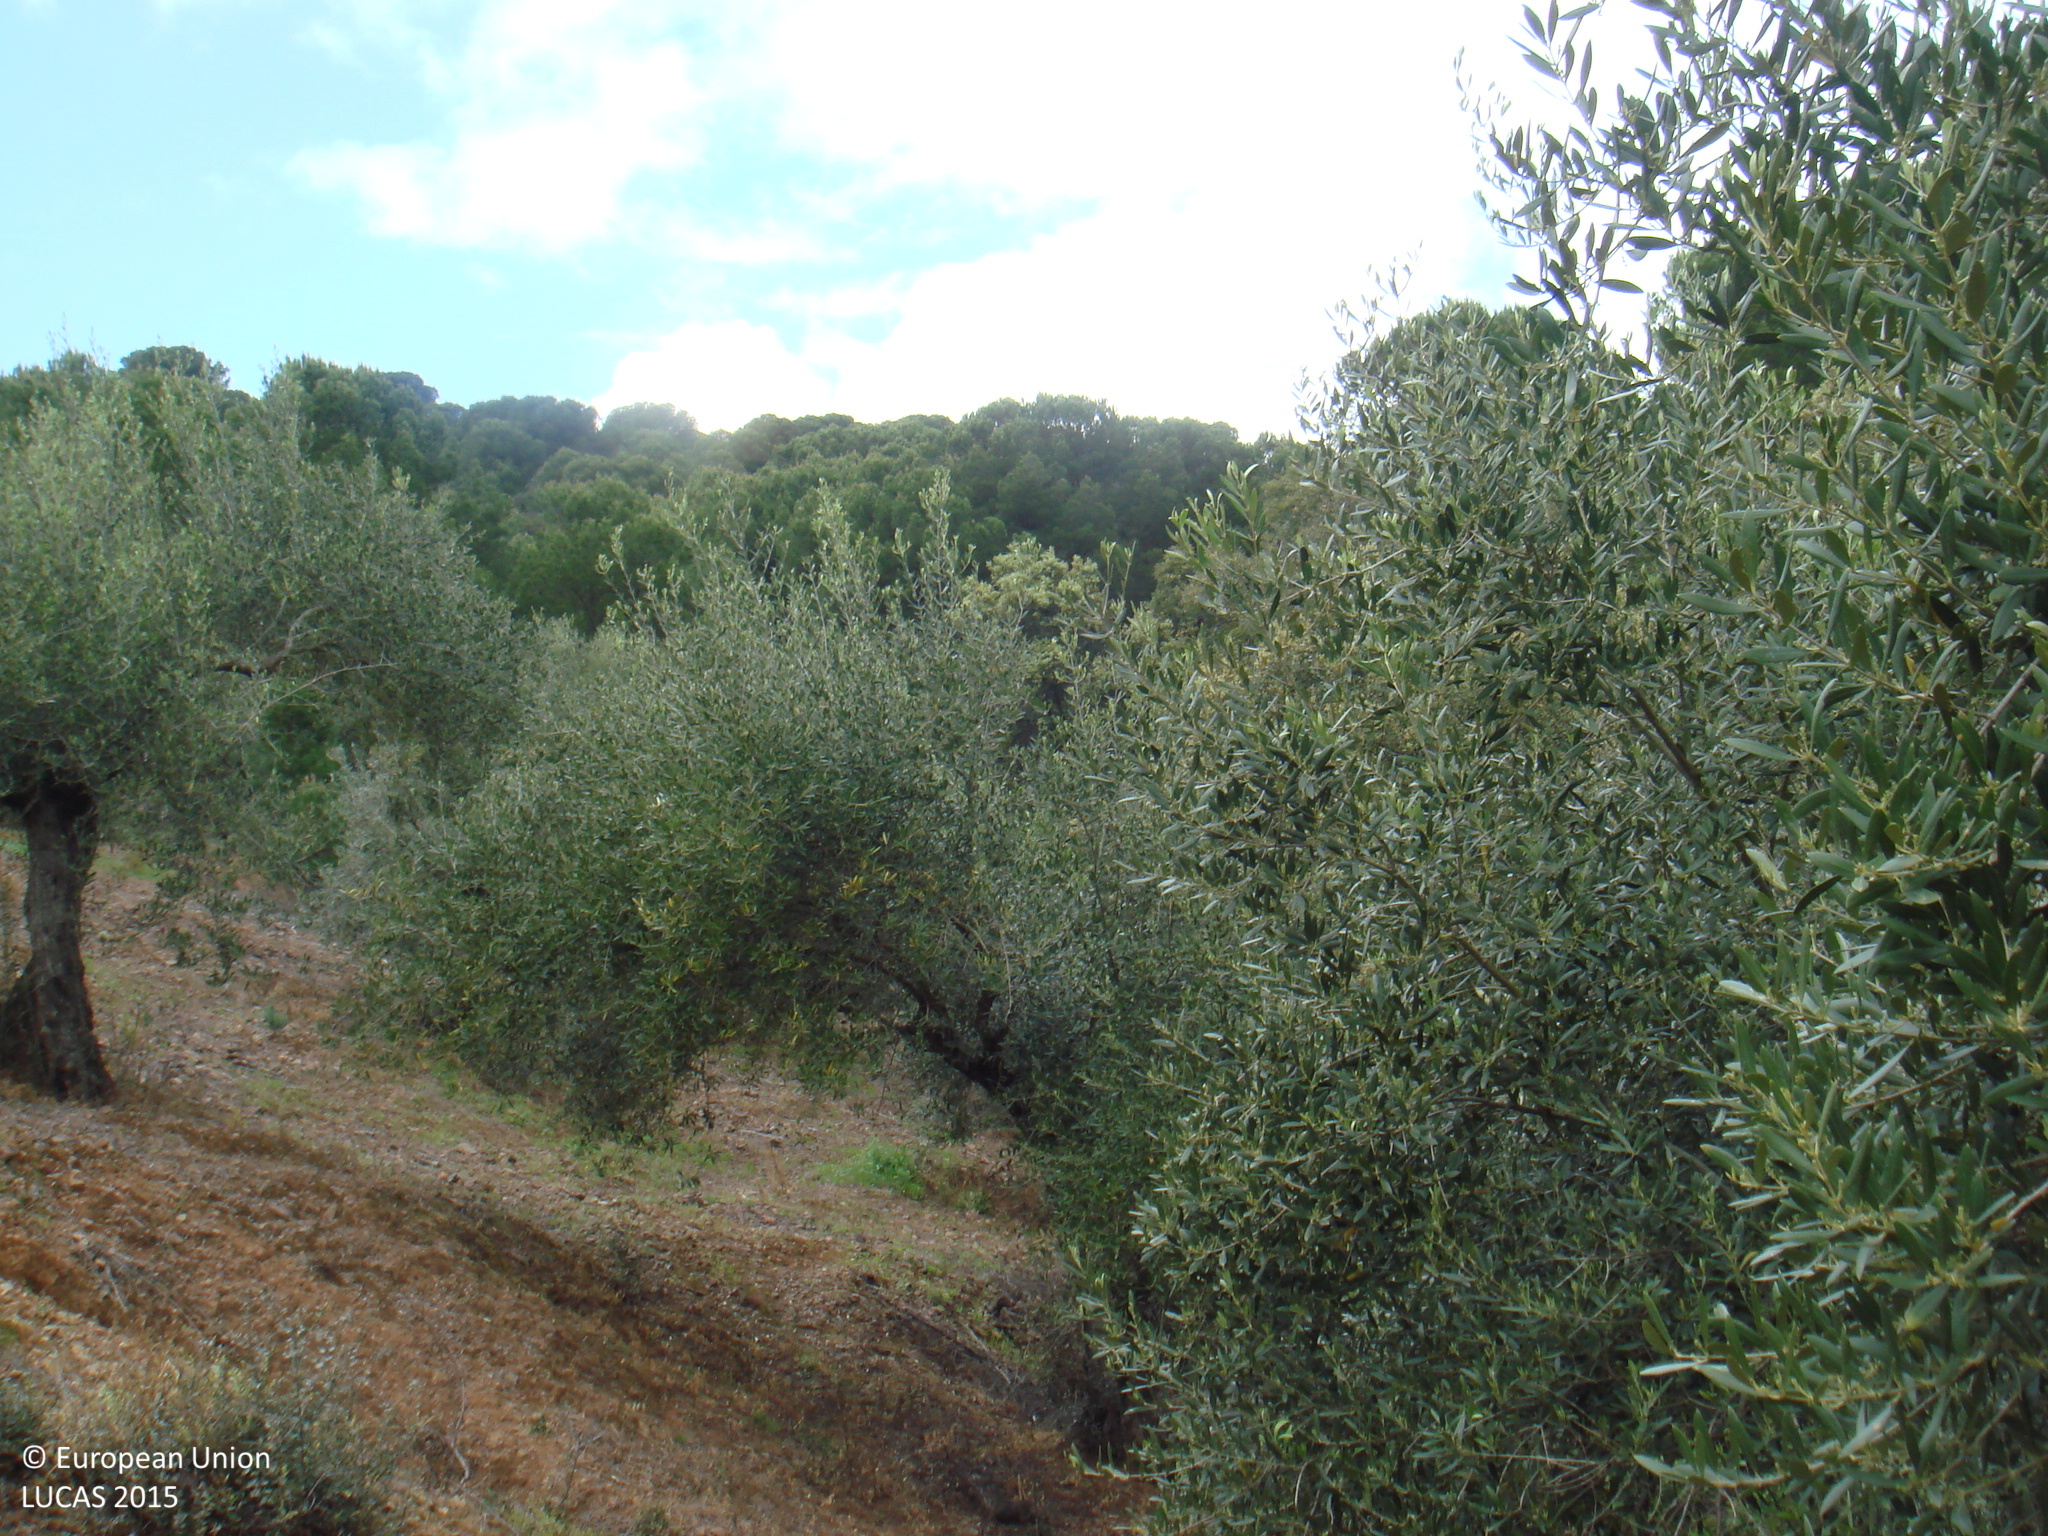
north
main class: Cropland
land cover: Olive groves
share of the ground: 10 - 25 %
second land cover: Spontaneously vegetated surfaces
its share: 50 - 75 %
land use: Agriculture (excluding fallow land and kitchen gardens)
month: April
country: ES
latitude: 38.0580
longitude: -5.0075
